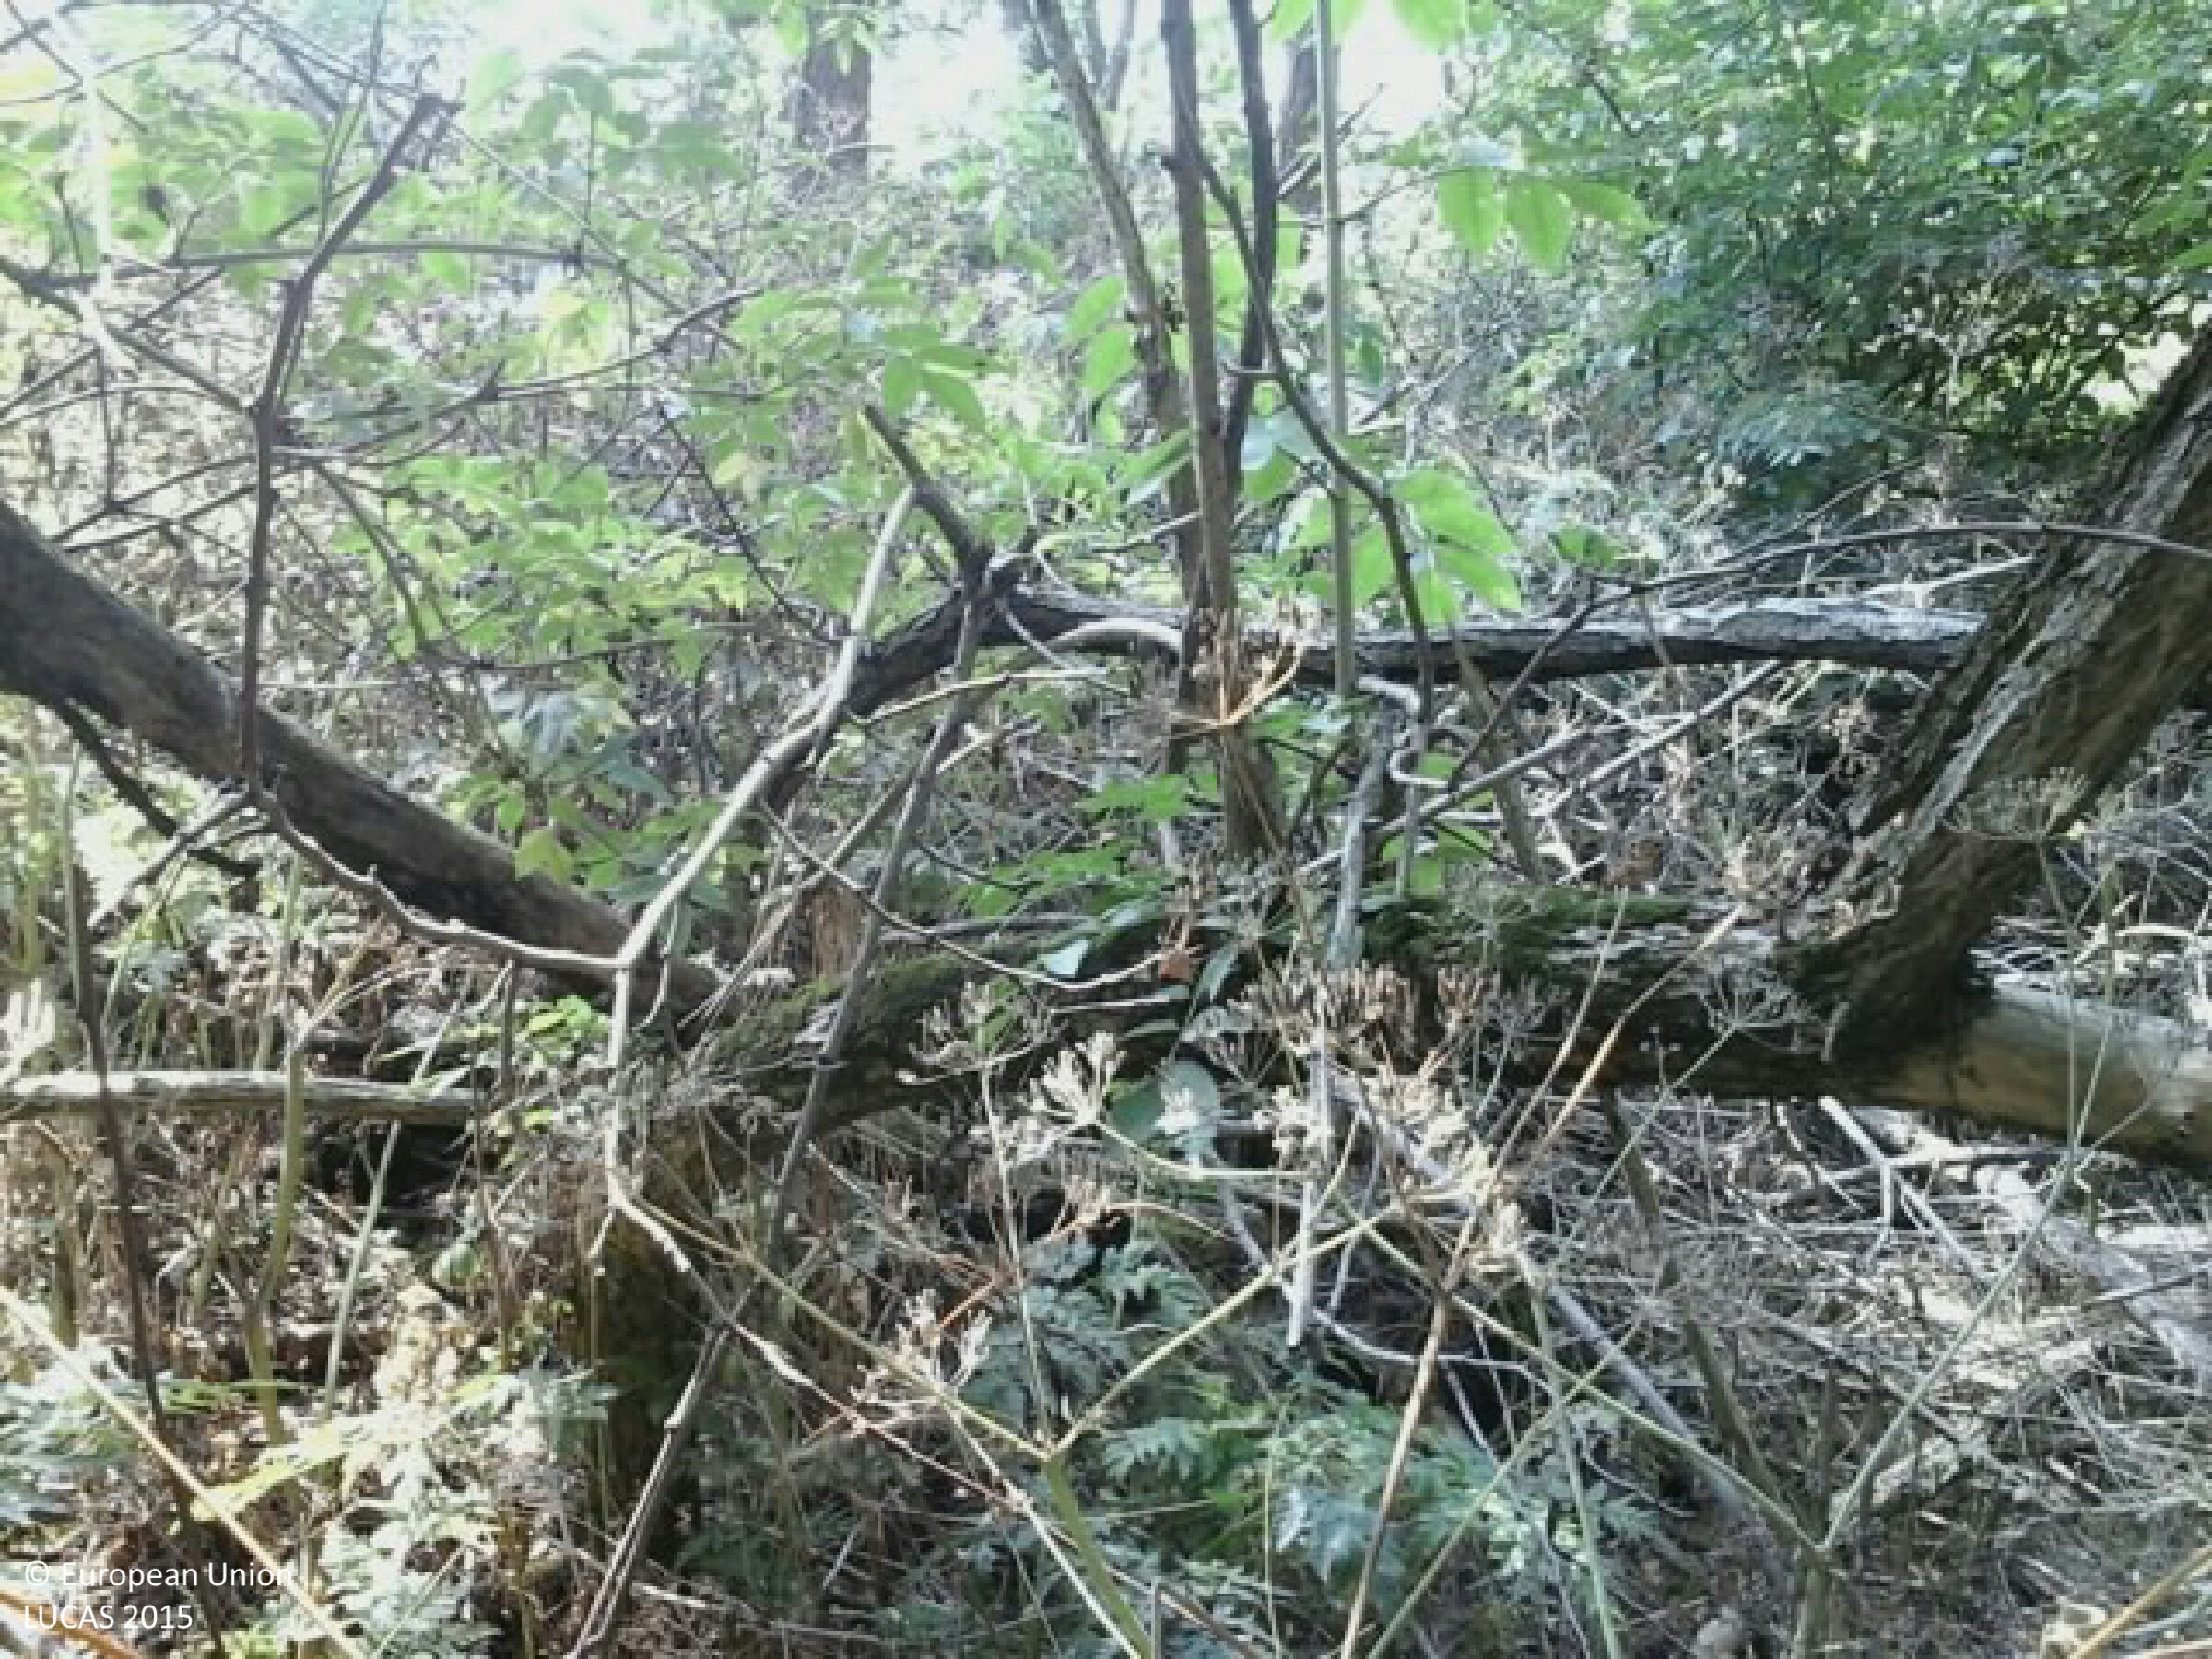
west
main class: Woodland
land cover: Broadleaved woodland
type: mesophytic deciduous forest
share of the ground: > 75 %
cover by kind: broadleaved forest trees 100 %
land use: Forestry
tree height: > 5 m
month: July
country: HU
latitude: 47.7712
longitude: 19.3485
